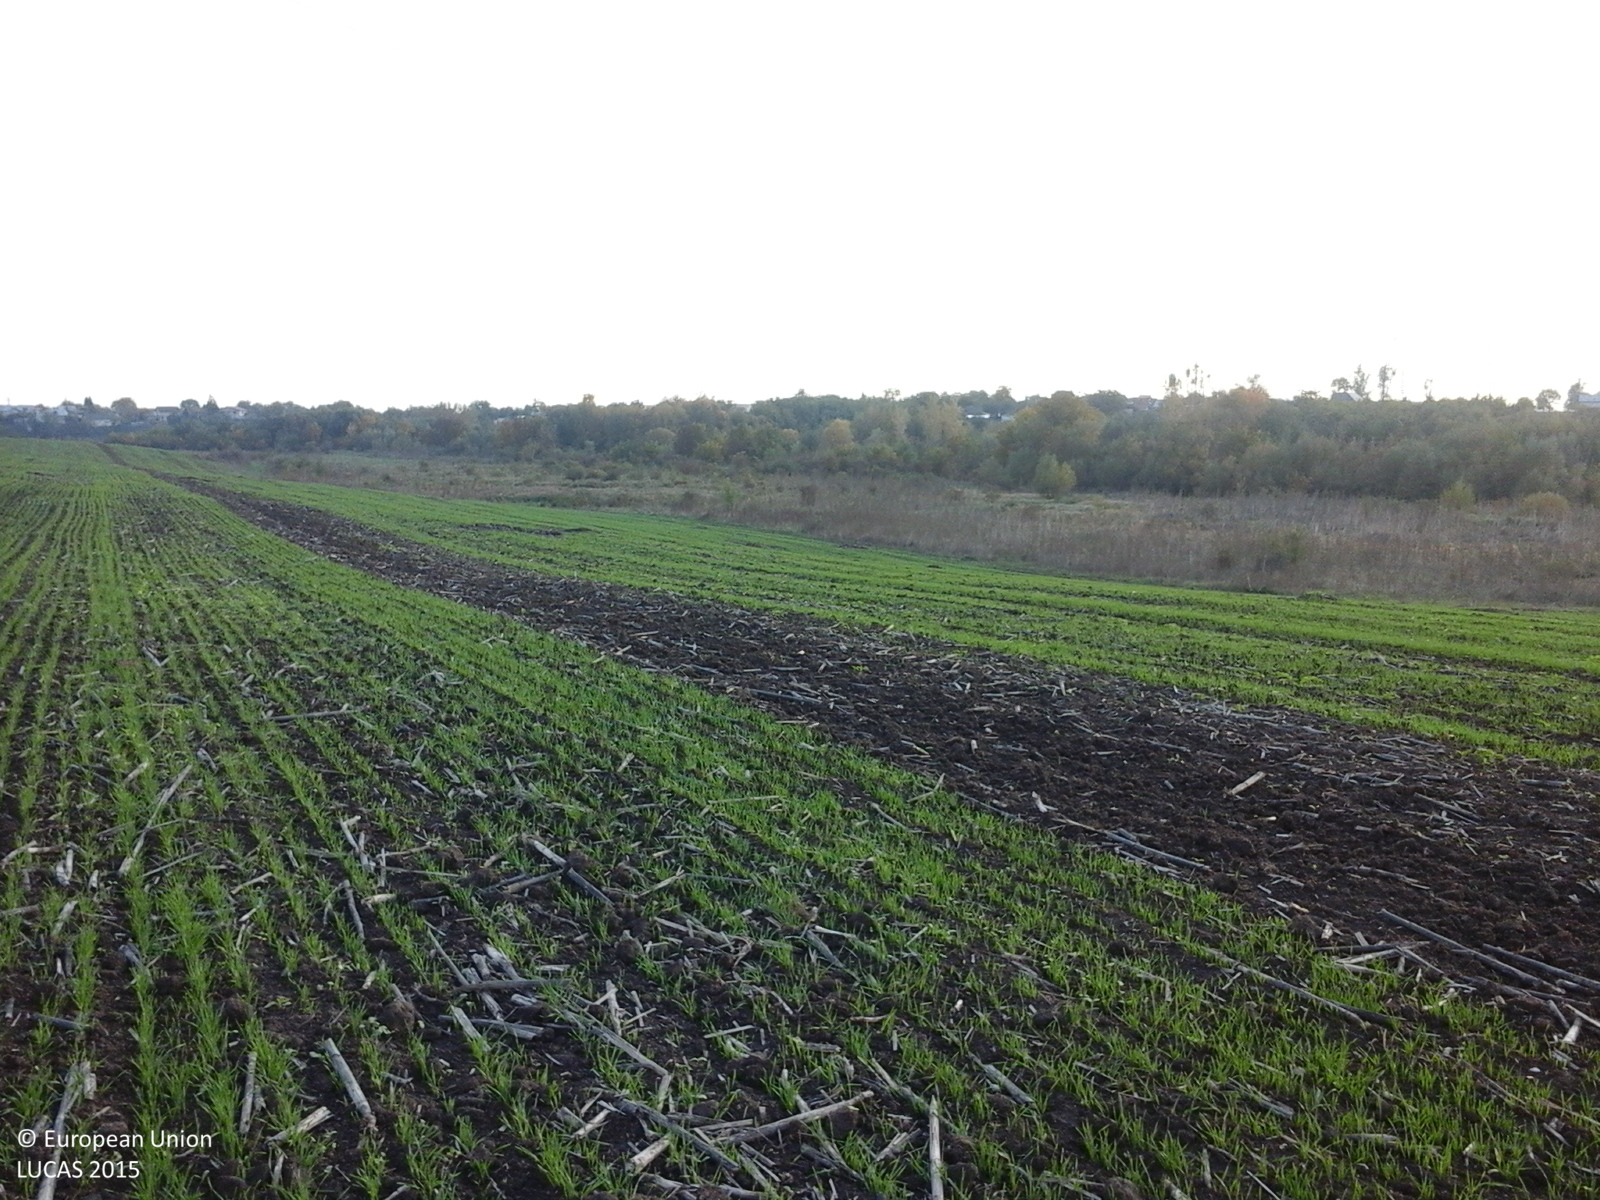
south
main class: Cropland
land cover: Common wheat
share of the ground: 25 - 50 %
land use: Agriculture (excluding fallow land and kitchen gardens)
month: October
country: RO
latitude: 44.6837
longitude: 25.9634
